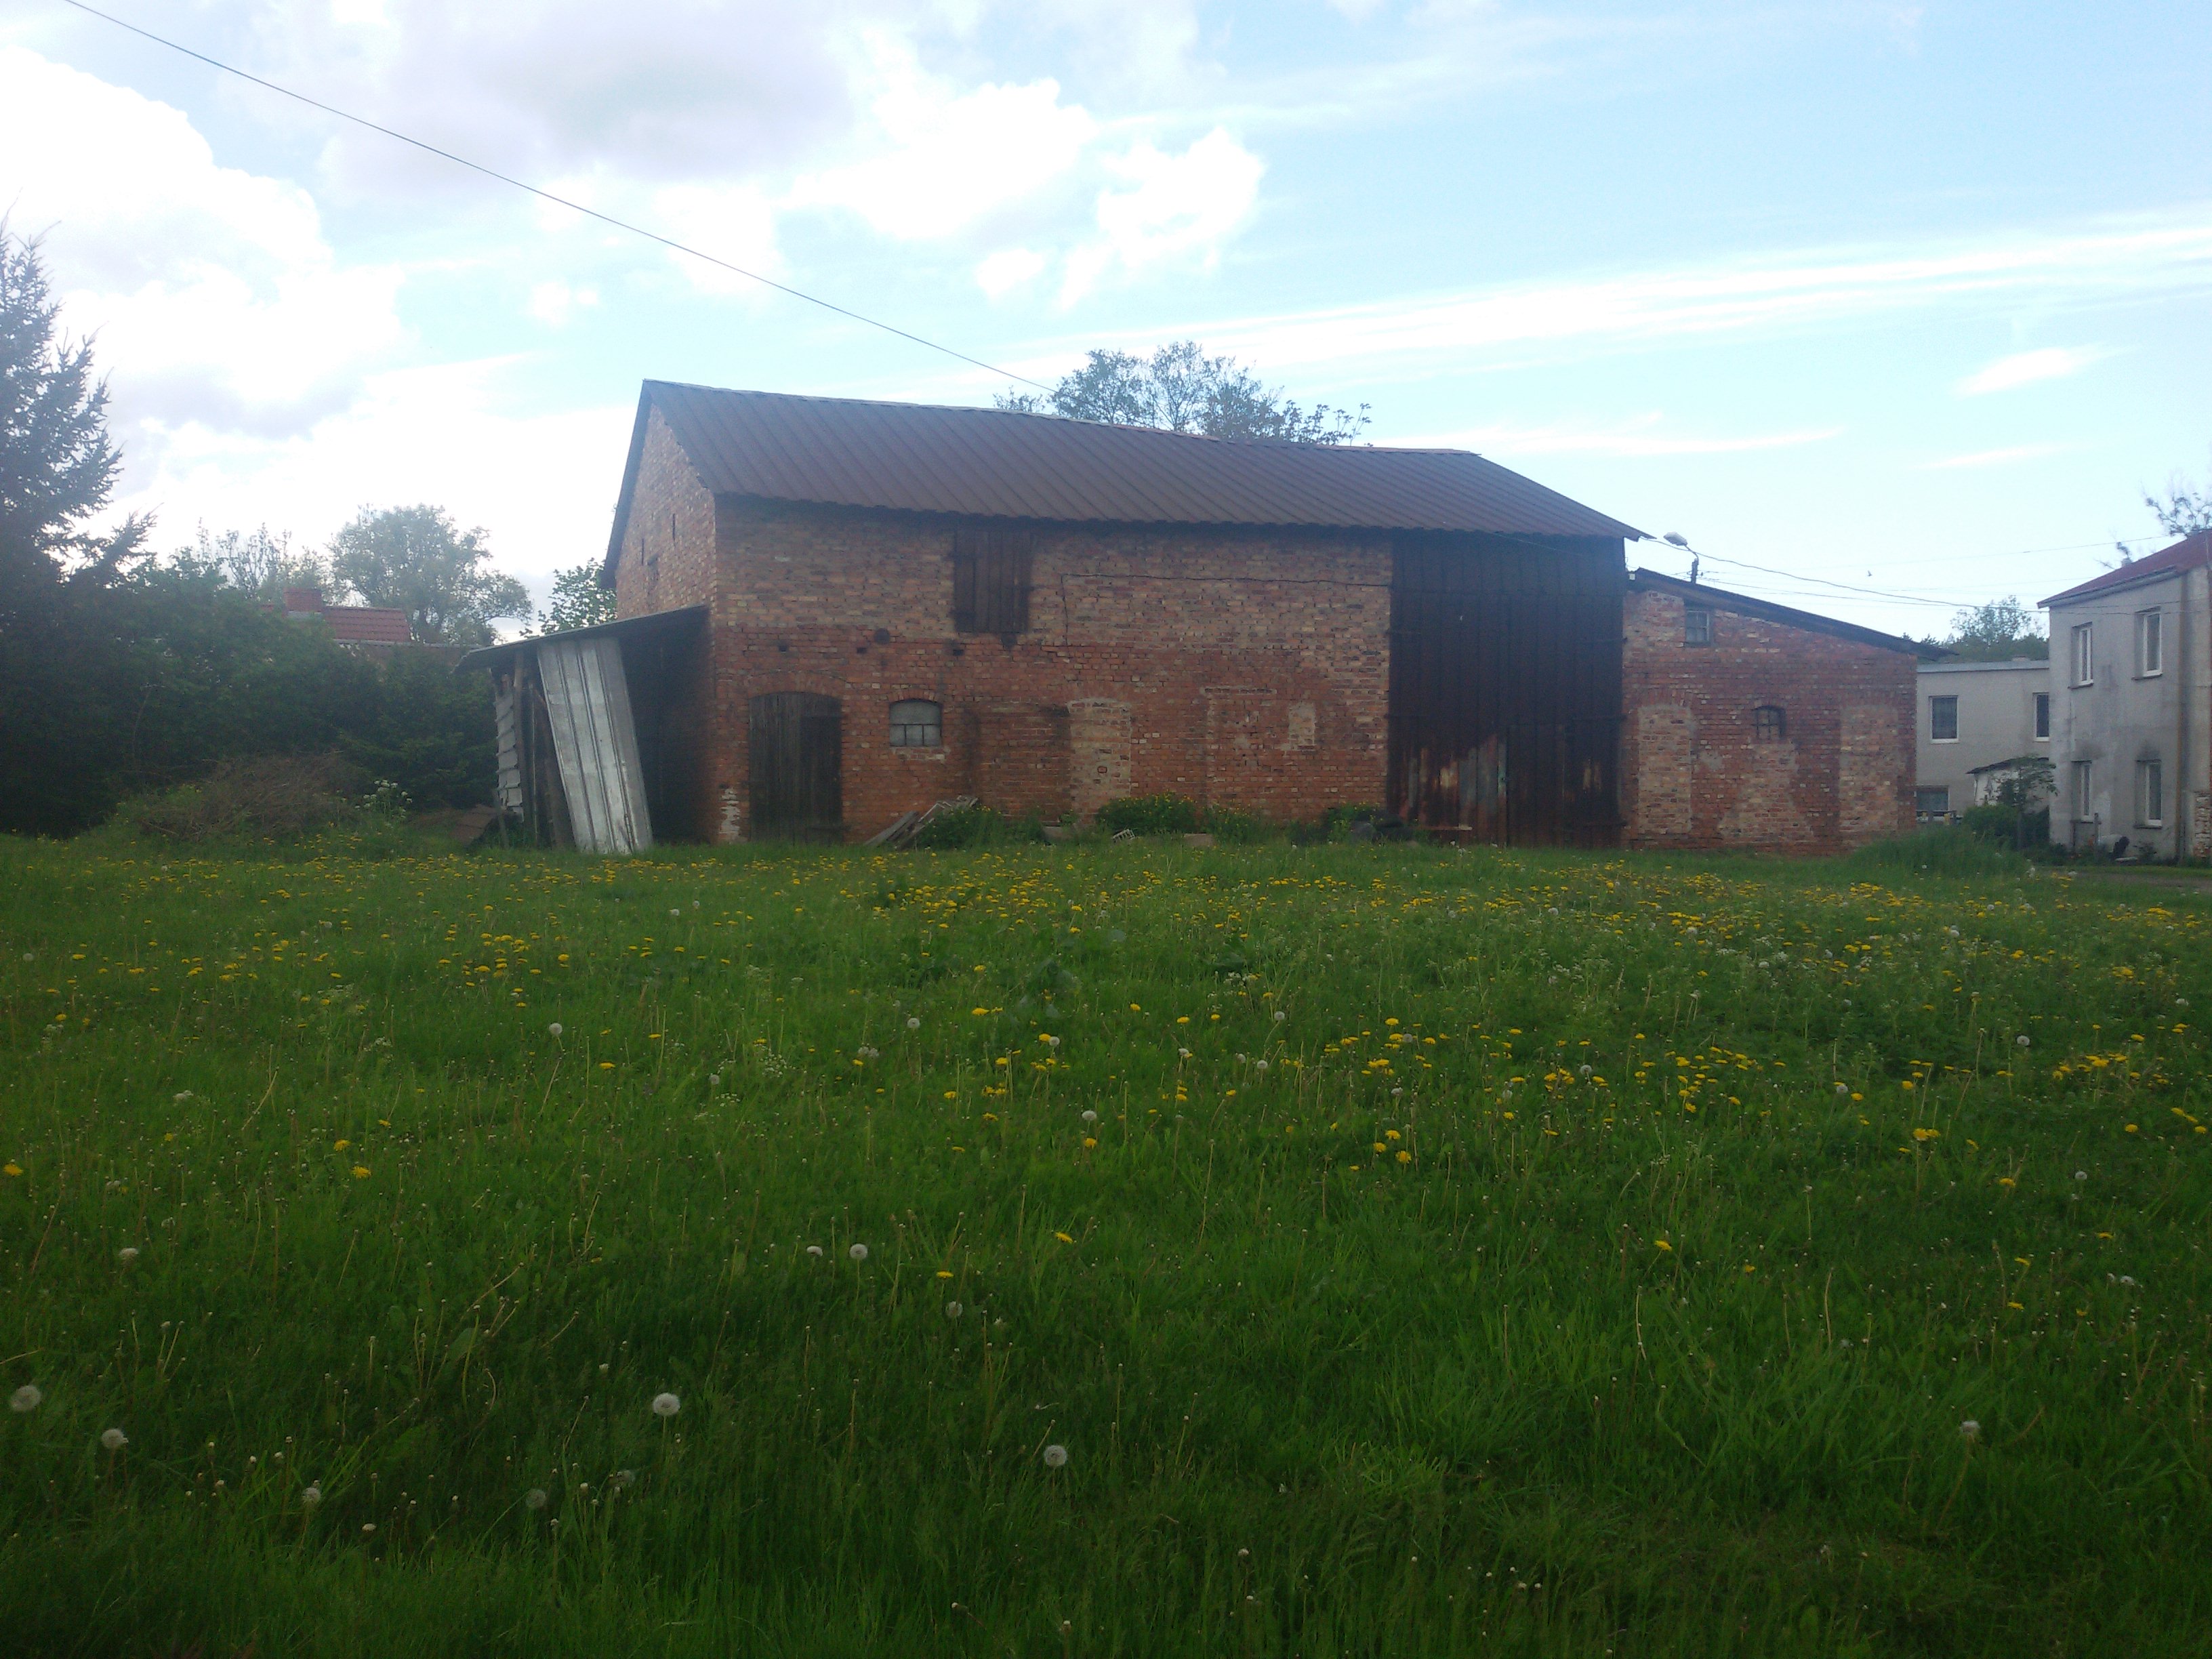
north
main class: Grassland
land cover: Grassland with sparse tree/shrub cover
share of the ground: 50 - 75 %
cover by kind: herbaceous plants 85 %, shrubs 10 %, broadleaved forest trees 5 %
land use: Residential
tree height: < 5 m
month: May
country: PL
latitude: 53.5698
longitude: 14.5160
